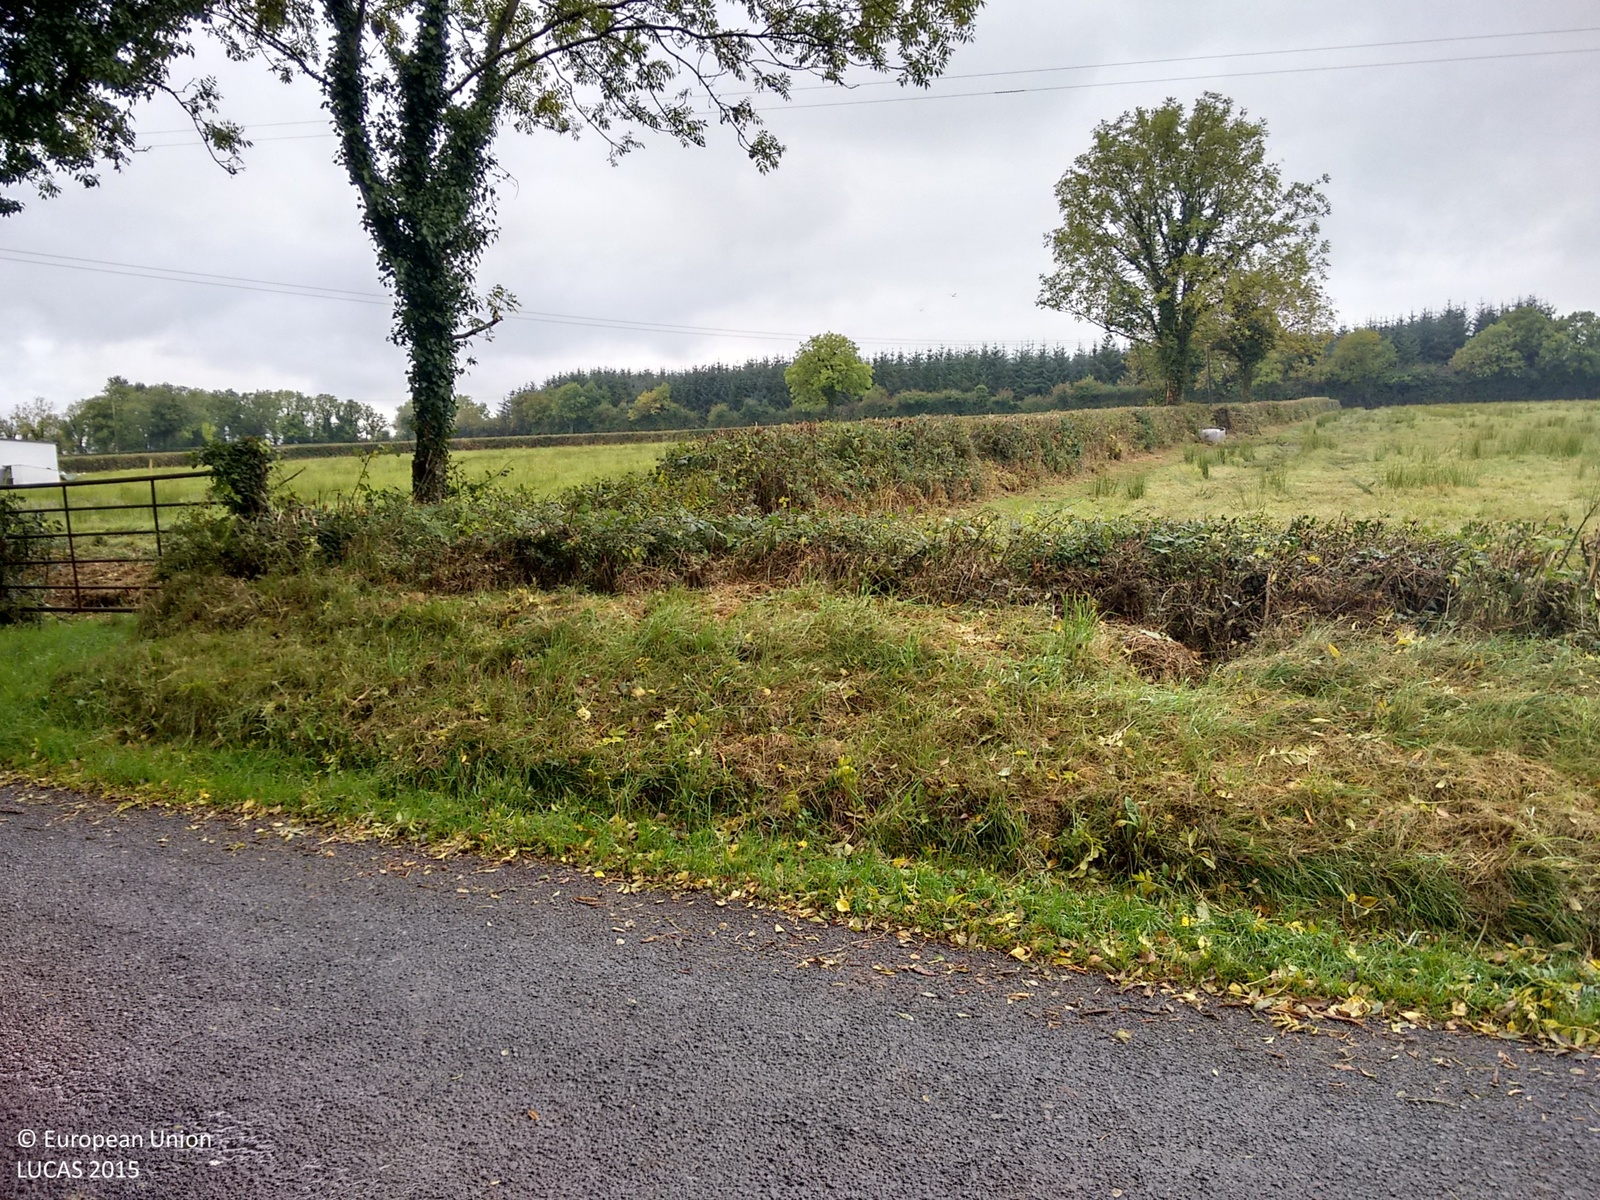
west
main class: Grassland
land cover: Grassland without tree/shrub cover
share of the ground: > 75 %
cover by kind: herbaceous plants 100 %
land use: Agriculture (excluding fallow land and kitchen gardens)
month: October
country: IE
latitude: 53.7927
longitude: -7.9804
